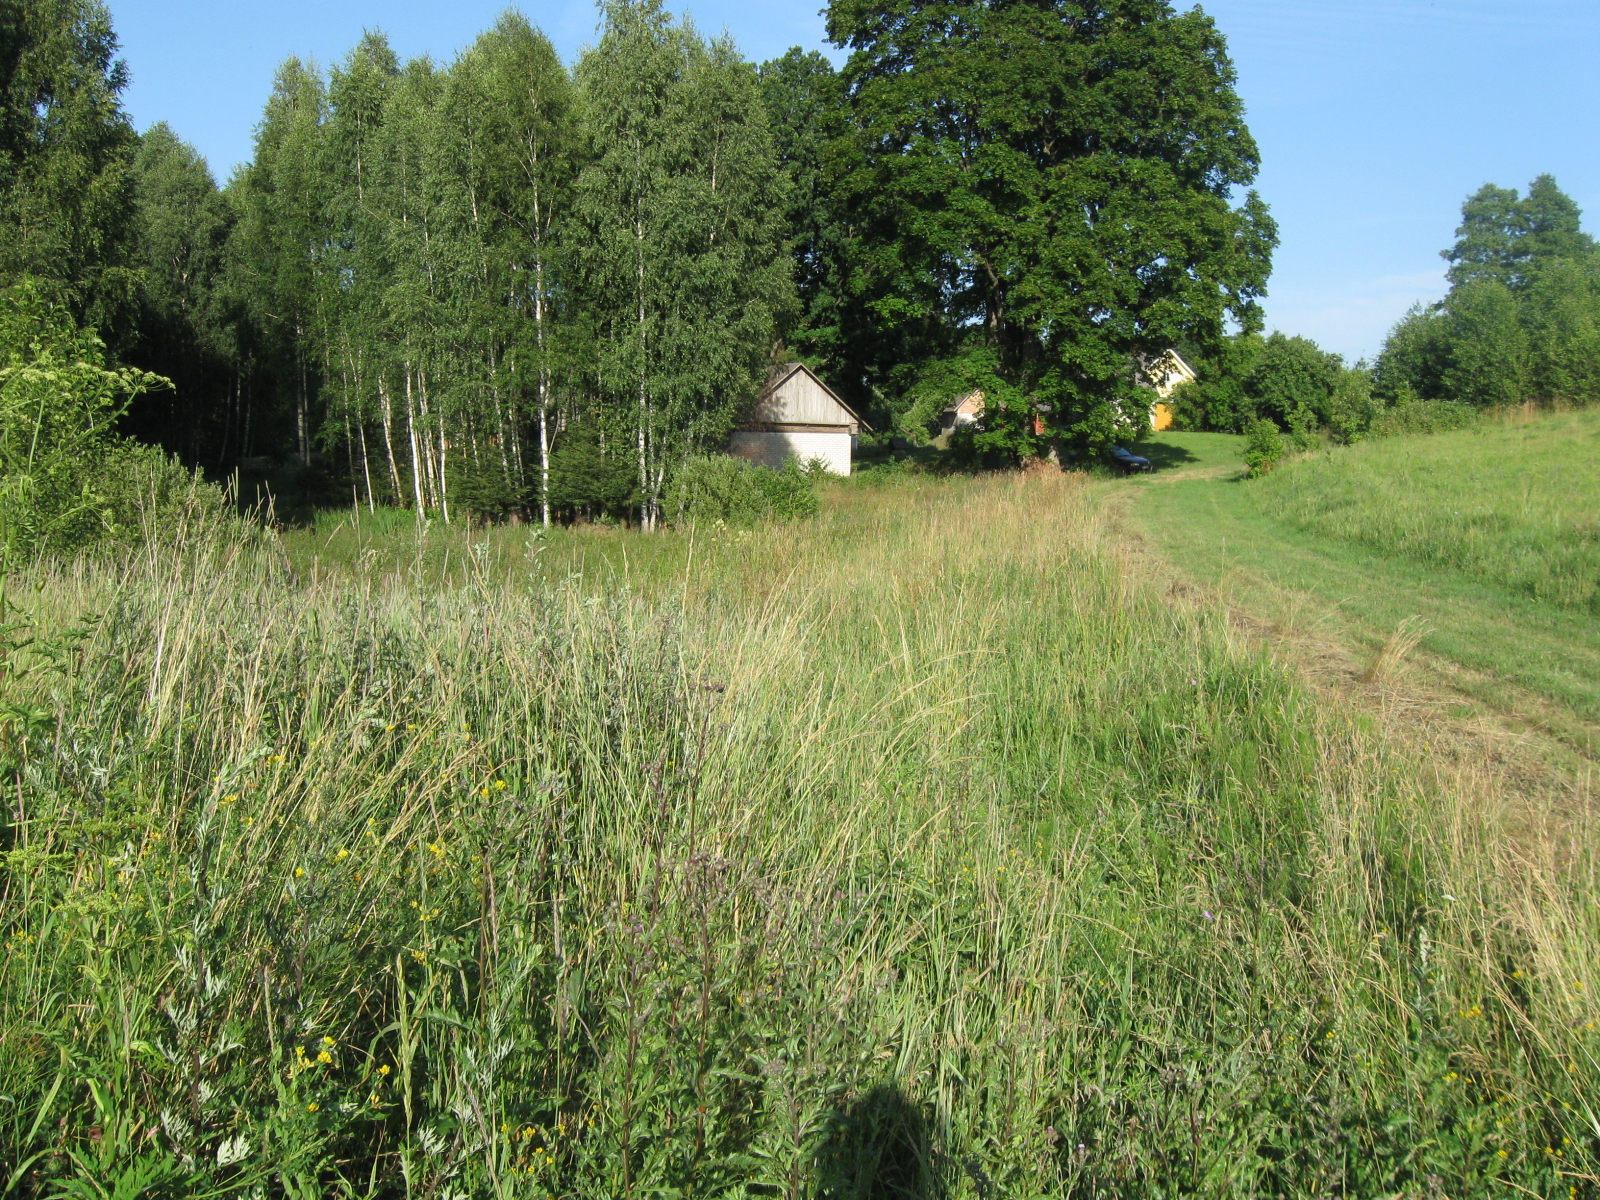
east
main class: Grassland
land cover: Spontaneously vegetated surfaces
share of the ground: > 75 %
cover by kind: herbaceous plants 100 %
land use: Agriculture (excluding fallow land and kitchen gardens)
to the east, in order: Spontaneously vegetated surfaces; Other mixed woodland; Grassland without tree/shrub cover; Artificial constructions in urban areas; Apple fruit; Grassland without tree/shrub cover; Broadleaved woodland; Inland marshes; Inland fresh water bodies
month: July
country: LT
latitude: 54.4549
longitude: 24.3993
